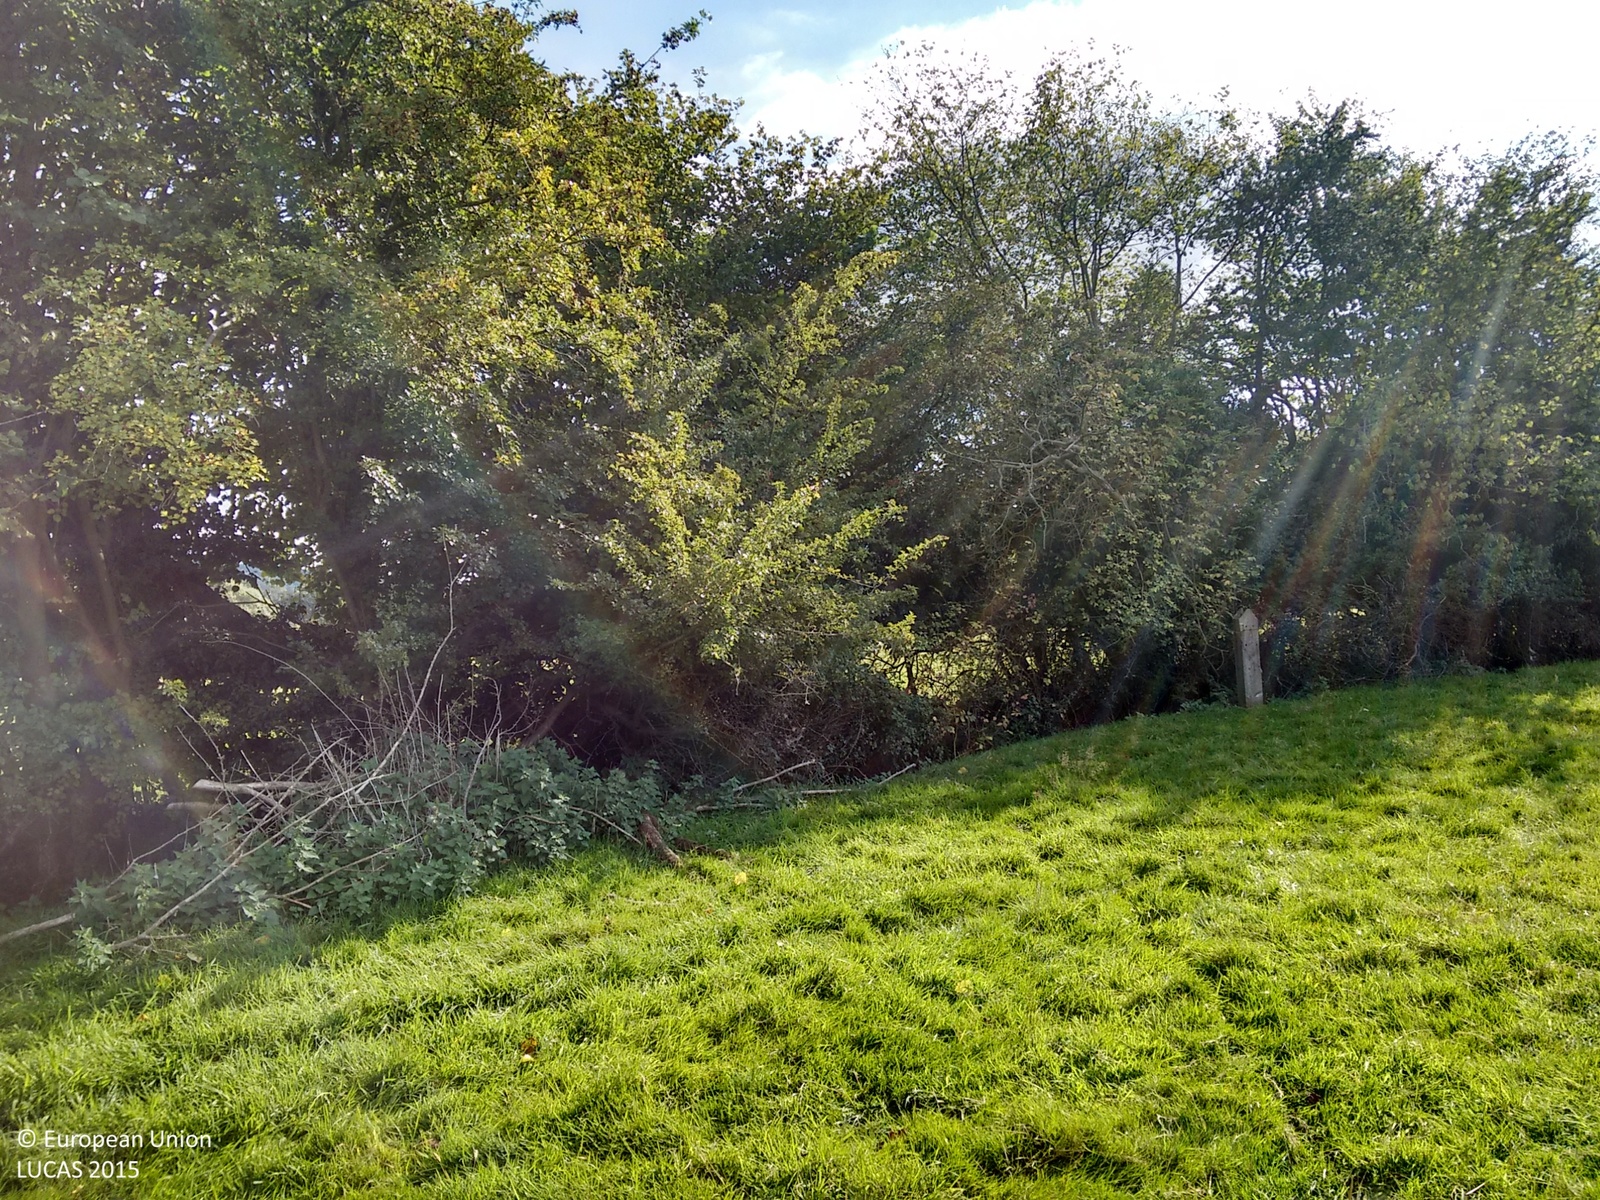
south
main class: Grassland
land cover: Grassland without tree/shrub cover
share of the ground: > 75 %
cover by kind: herbaceous plants 100 %
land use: Agriculture (excluding fallow land and kitchen gardens)
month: September
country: GB
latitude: 51.8642
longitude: -2.4528
